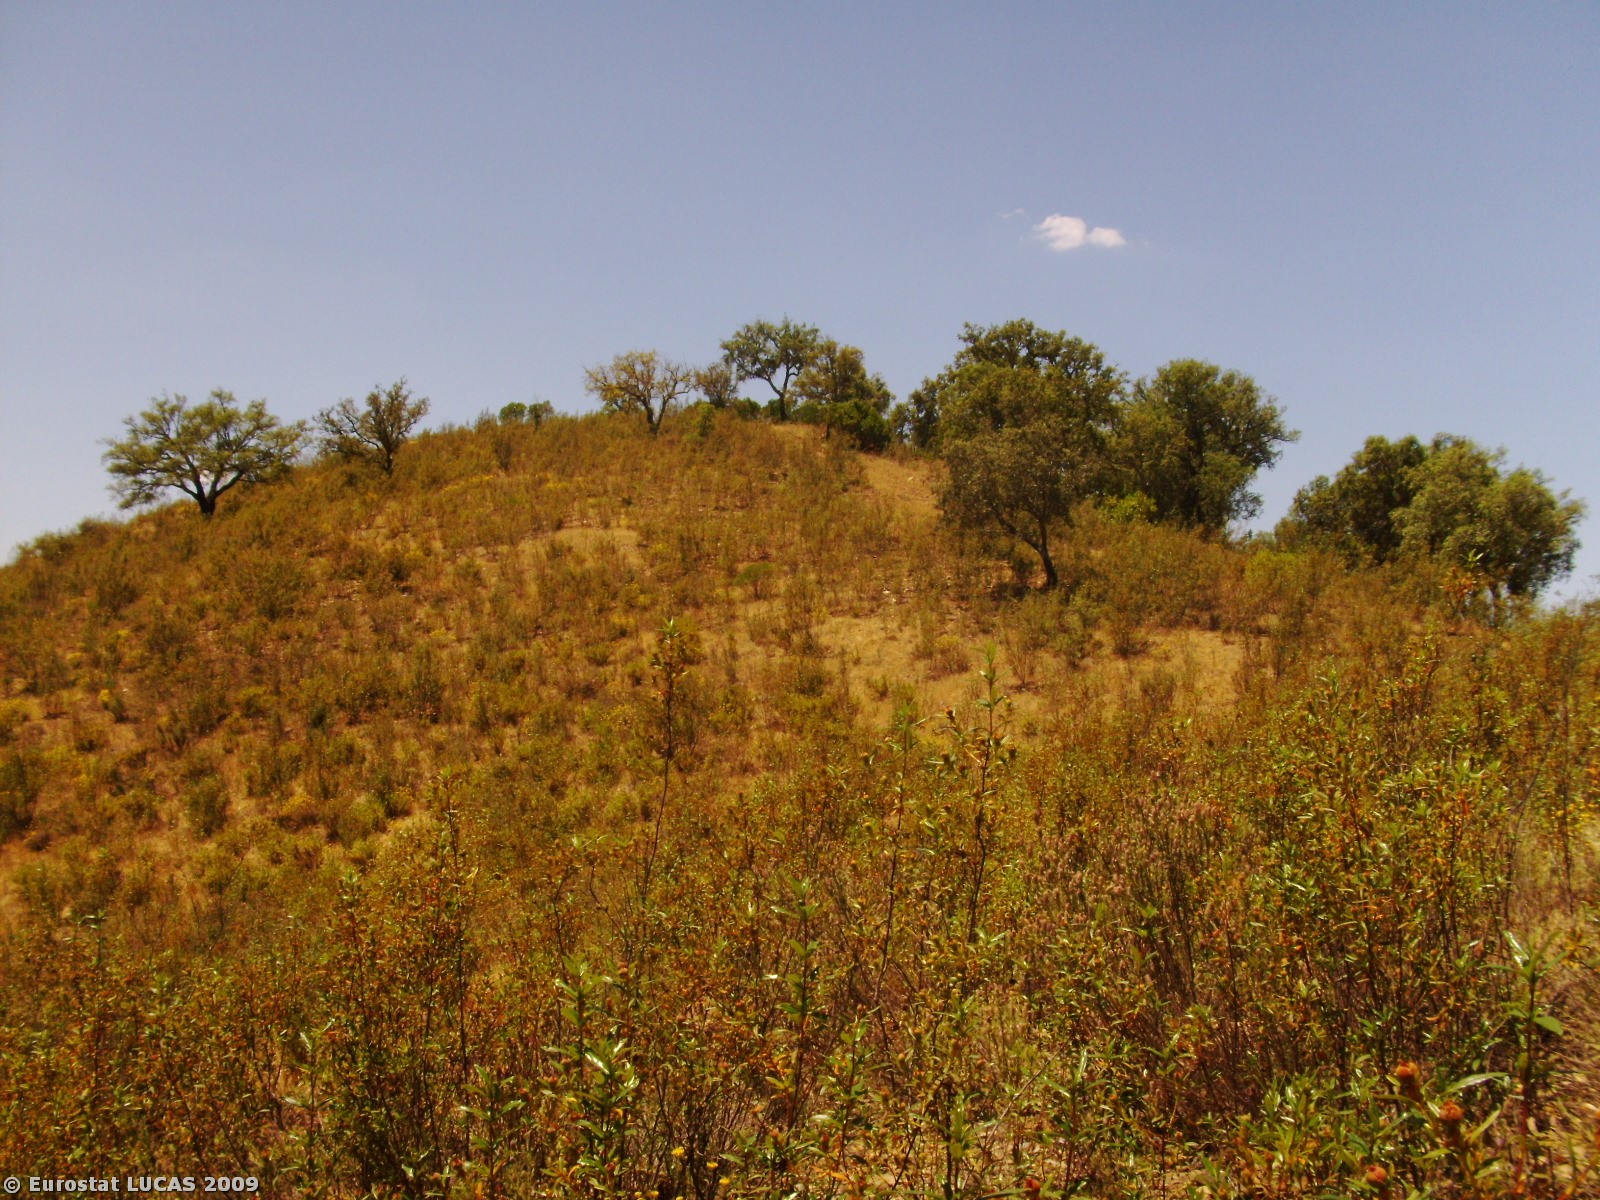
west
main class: Shrubland
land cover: Shrubland without tree cover
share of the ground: 50 - 75 %
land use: Unused
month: May
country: PT
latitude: 37.4676
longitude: -8.2404
